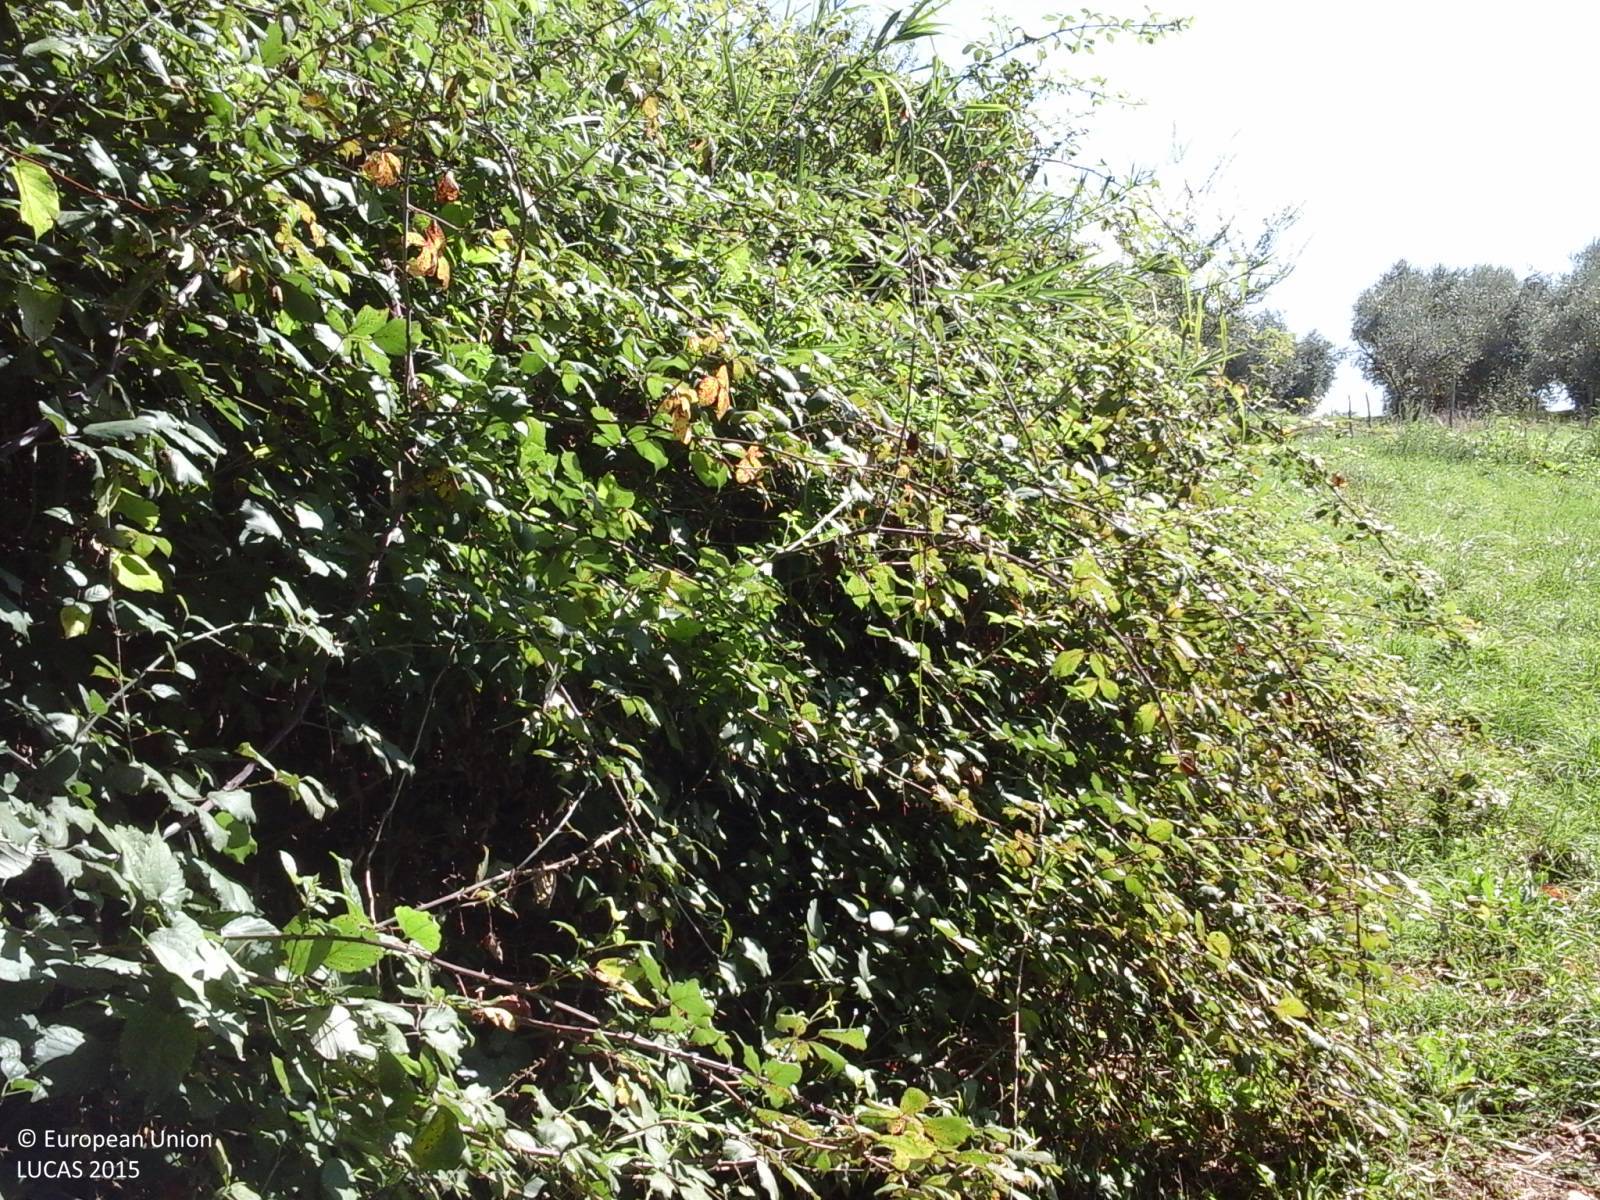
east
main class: Woodland
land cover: Broadleaved woodland
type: thermophilous deciduous forest
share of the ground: > 75 %
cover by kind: broadleaved forest trees 90 %, shrubs 10 %
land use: Abandoned areas
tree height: > 5 m
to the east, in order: Broadleaved woodland; Managed hedges; Fences; Olive groves; Artificial constructions in urban areas; Grassland without tree/shrub cover; Fences; Grassland without tree/shrub cover
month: September
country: IT
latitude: 42.3135
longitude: 12.5996
